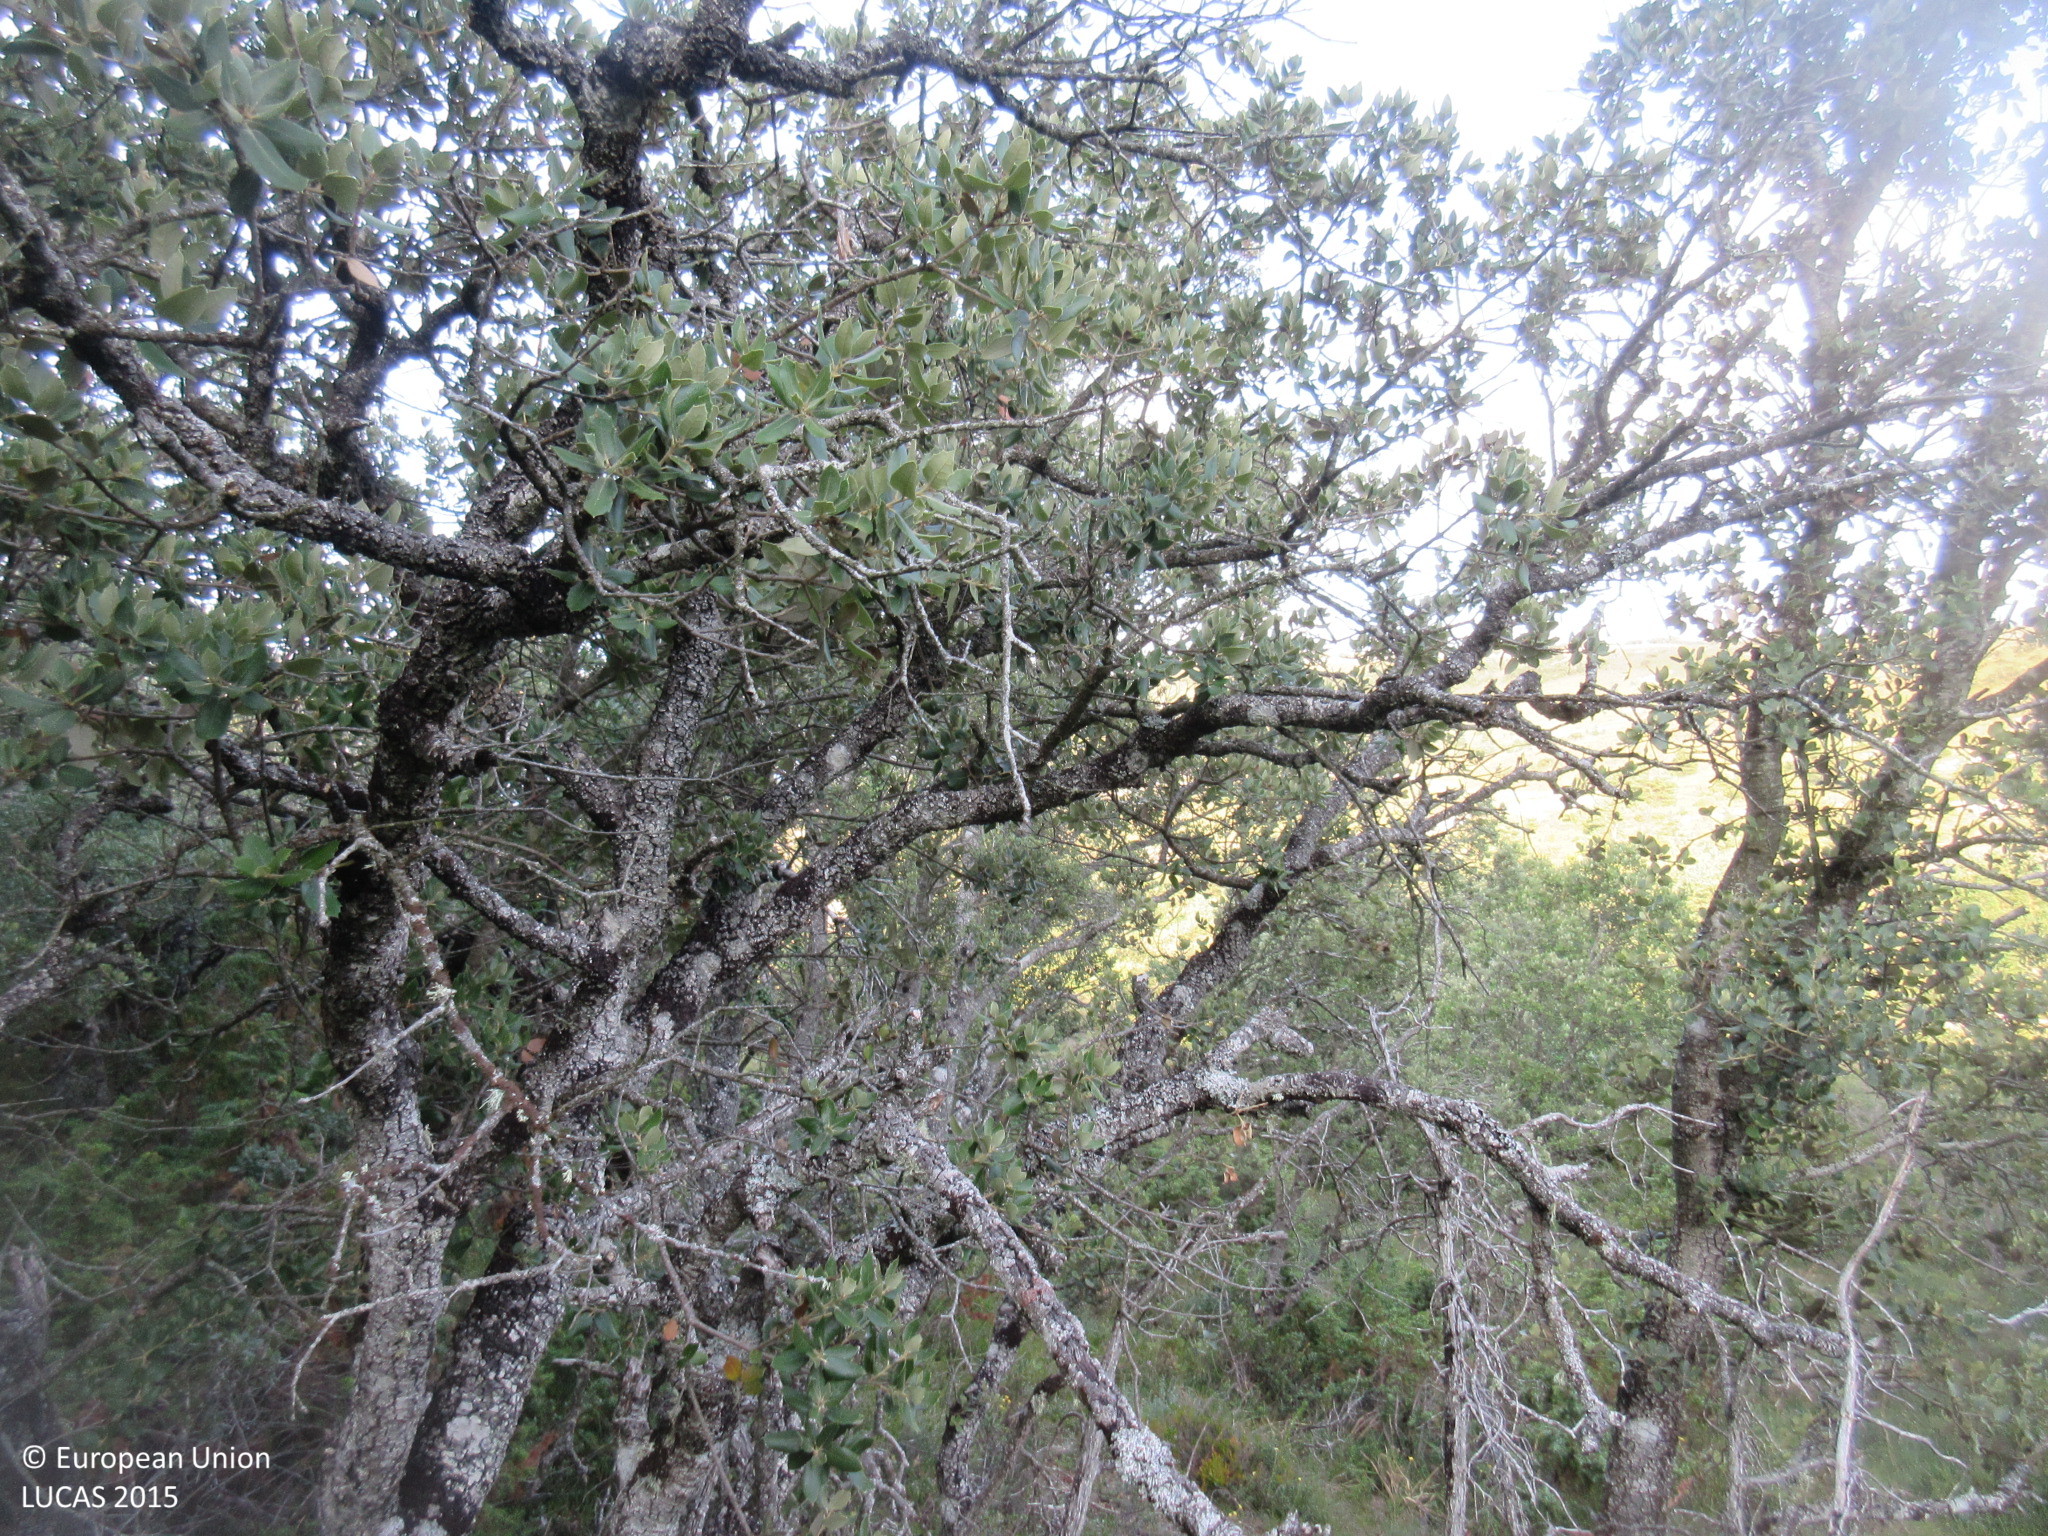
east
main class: Woodland
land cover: Broadleaved woodland
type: broadleaved evergreen forest
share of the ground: > 75 %
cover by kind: broadleaved forest trees 90 %, shrubs 10 %
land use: Semi-natural and natural areas not in use
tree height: > 5 m
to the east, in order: Broadleaved woodland; Dry stone walls; Broadleaved woodland; Shrubland with sparse tree cover; Common wheat
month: July
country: ES
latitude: 43.0055
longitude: -3.3732
